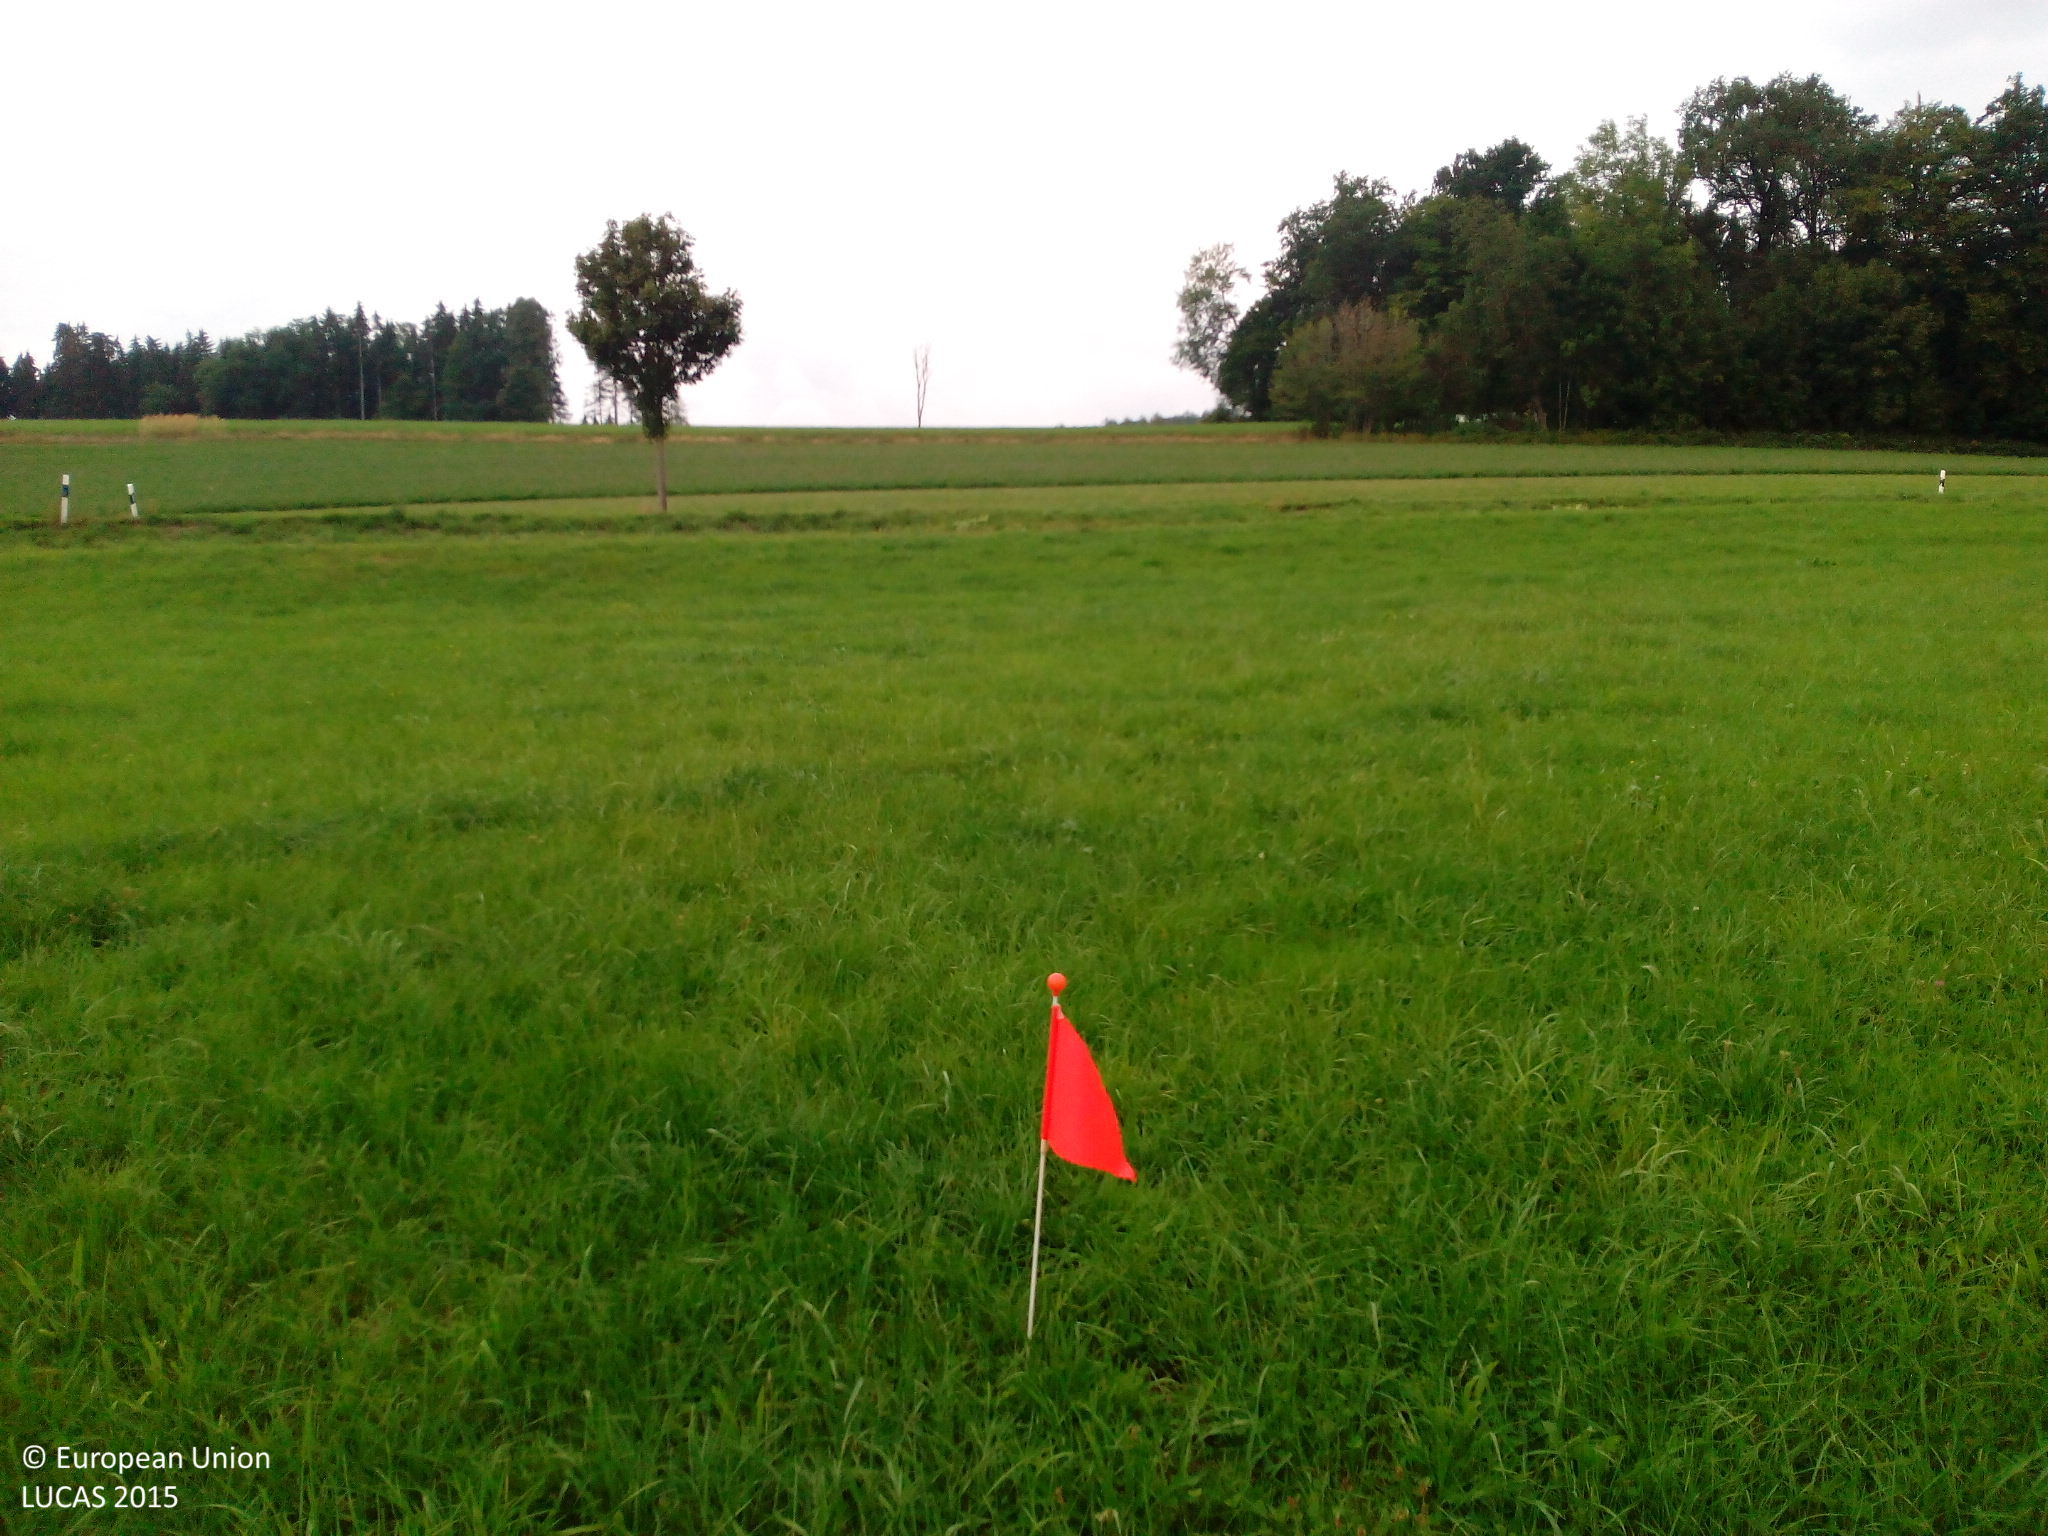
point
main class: Grassland
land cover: Grassland without tree/shrub cover
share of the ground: > 75 %
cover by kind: herbaceous plants 90 %, unconsolidated bare surface 10 %
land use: Agriculture (excluding fallow land and kitchen gardens)
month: September
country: DE
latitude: 48.2758
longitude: 10.6060
